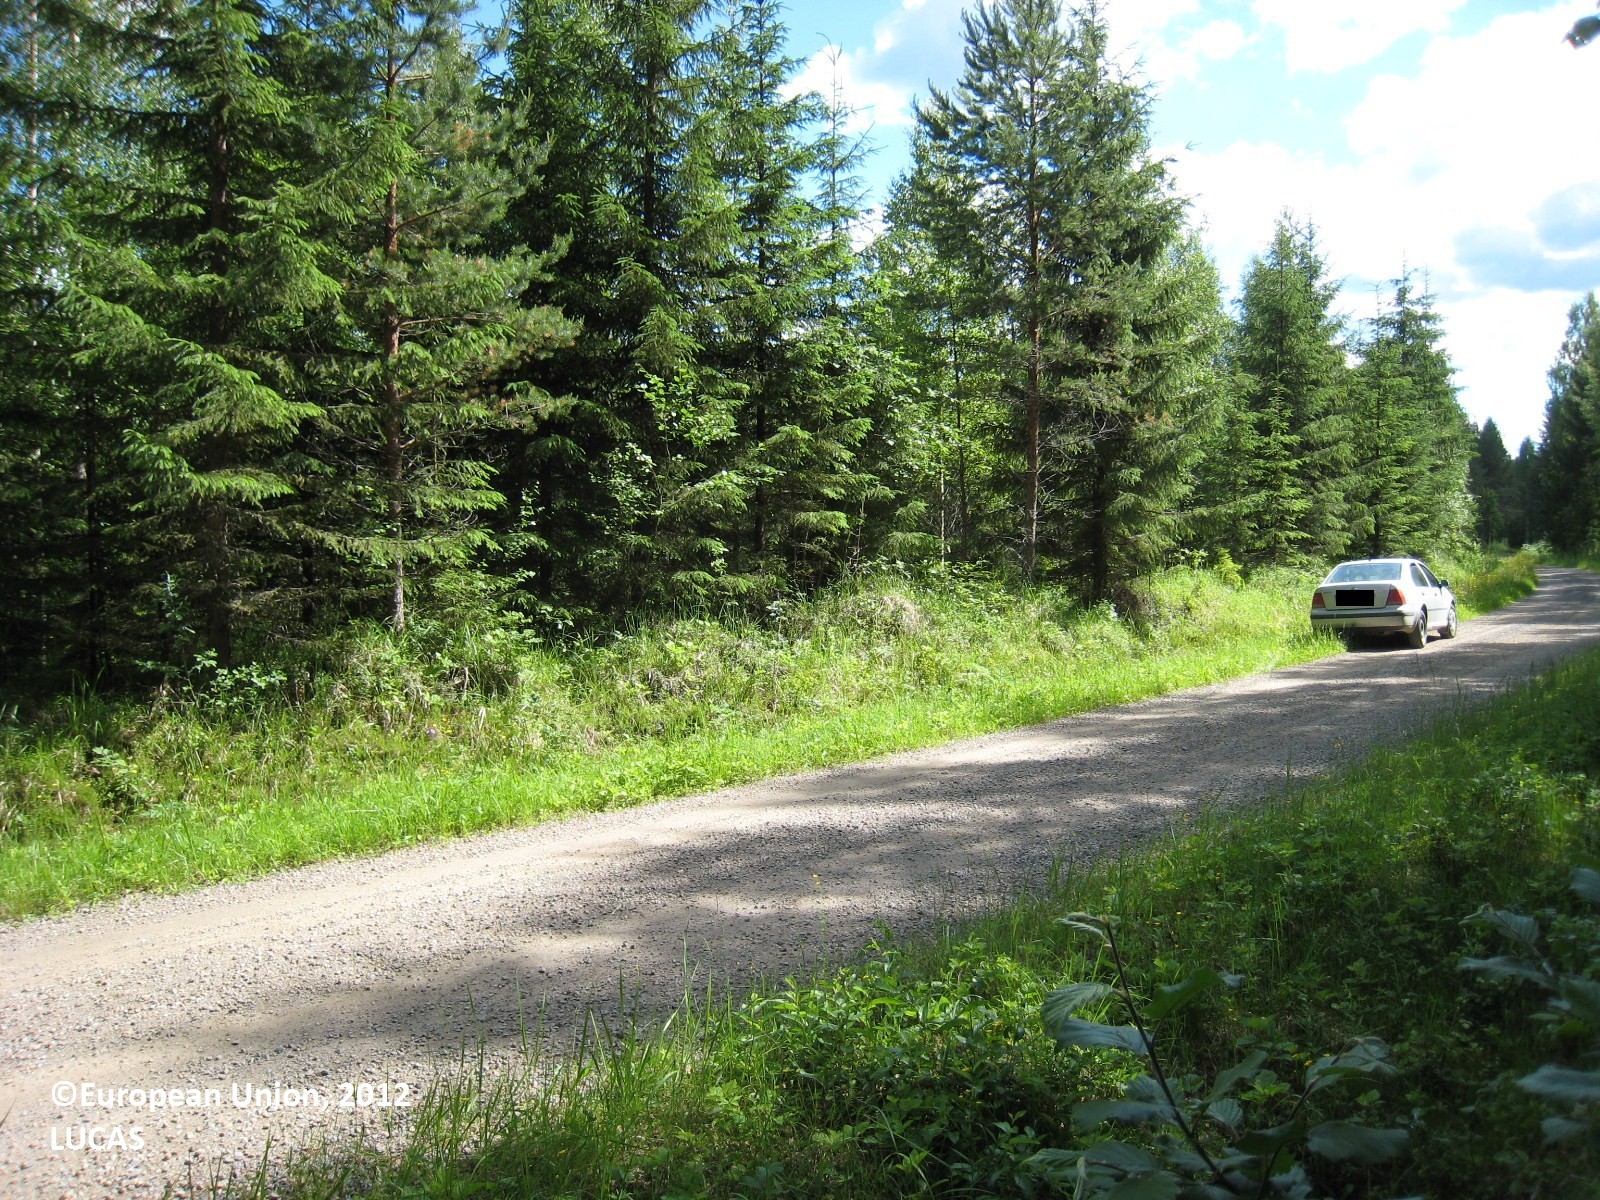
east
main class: Woodland
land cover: Other mixed woodland
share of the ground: 50 - 75 %
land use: Forestry
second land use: Road transport
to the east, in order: Other mixed woodland; Ditches and canals; Grass margins; Paved roads, cycling and walking lanes; Grass margins; Ditches and canals; Other mixed woodland; Other coniferous woodland; Other mixed woodland; Ditches and canals; Other mixed woodland; Ditches and canals; Other mixed woodland; Pine dominated mixed woodland
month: July
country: FI
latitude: 63.2226
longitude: 25.6868
